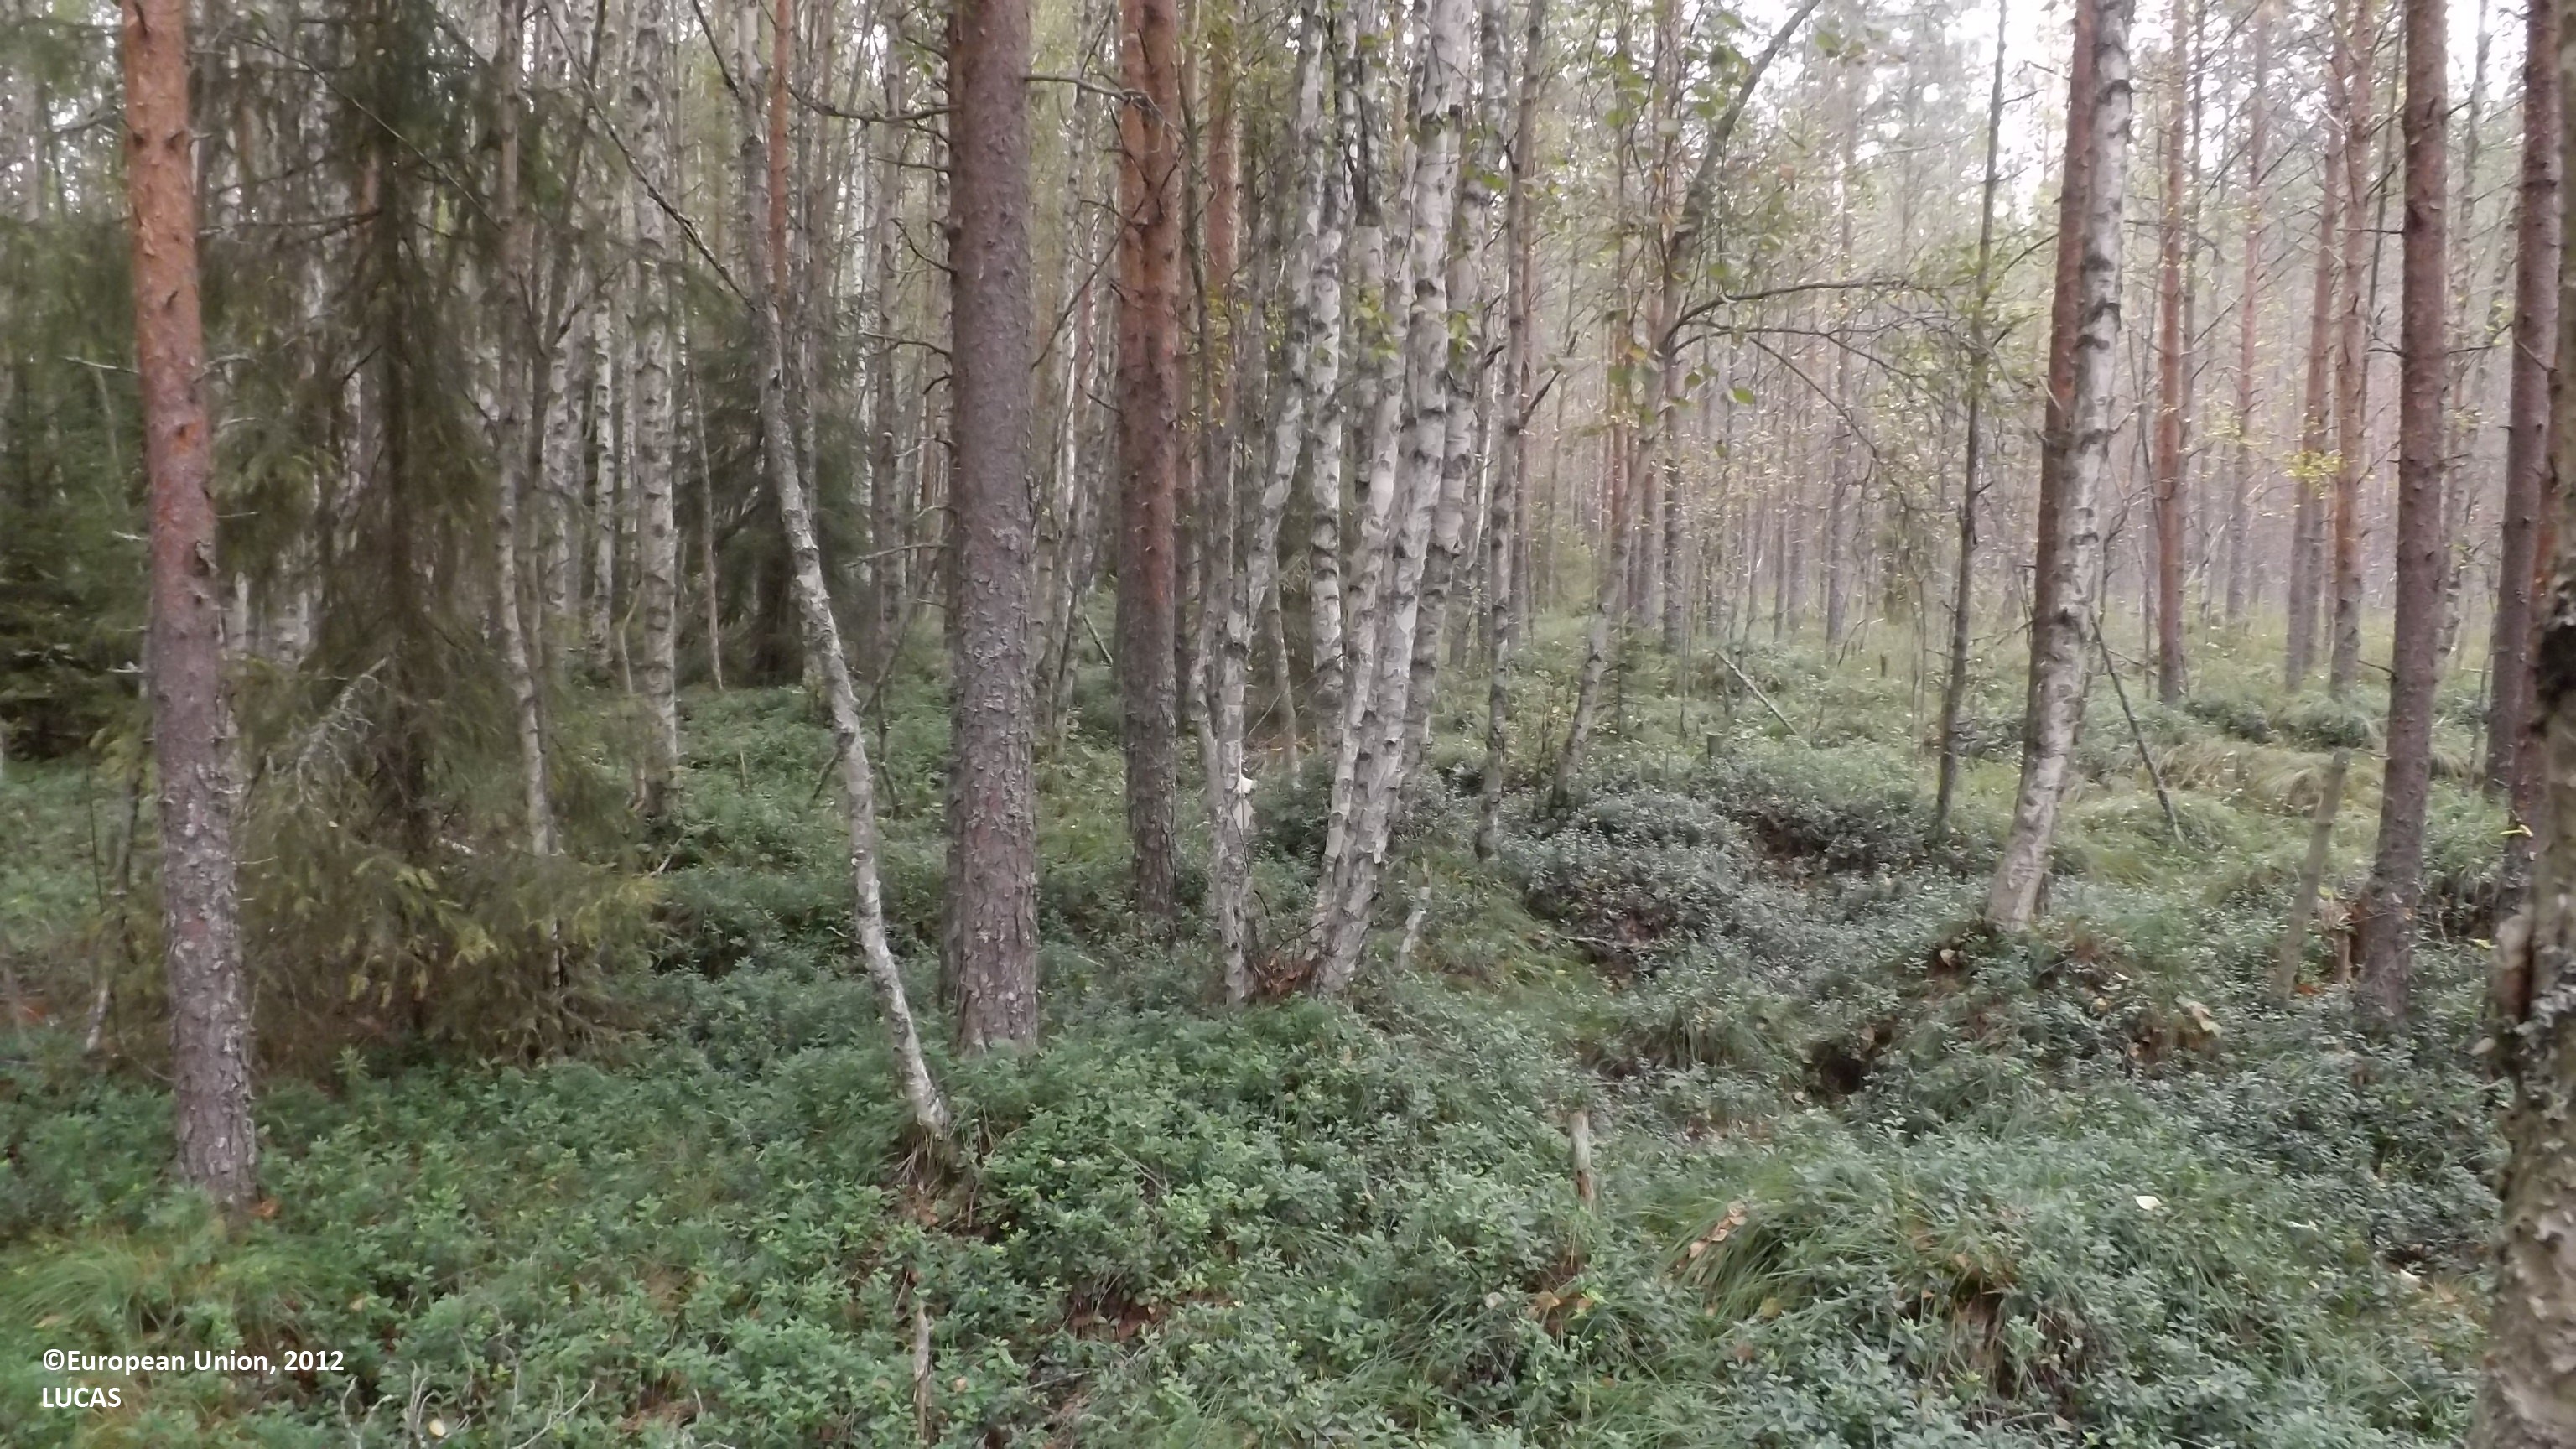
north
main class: Woodland
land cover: Pine dominated mixed woodland
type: boreal forest
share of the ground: > 75 %
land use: Forestry
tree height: > 5 m
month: August
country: FI
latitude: 63.8299
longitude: 23.5743
